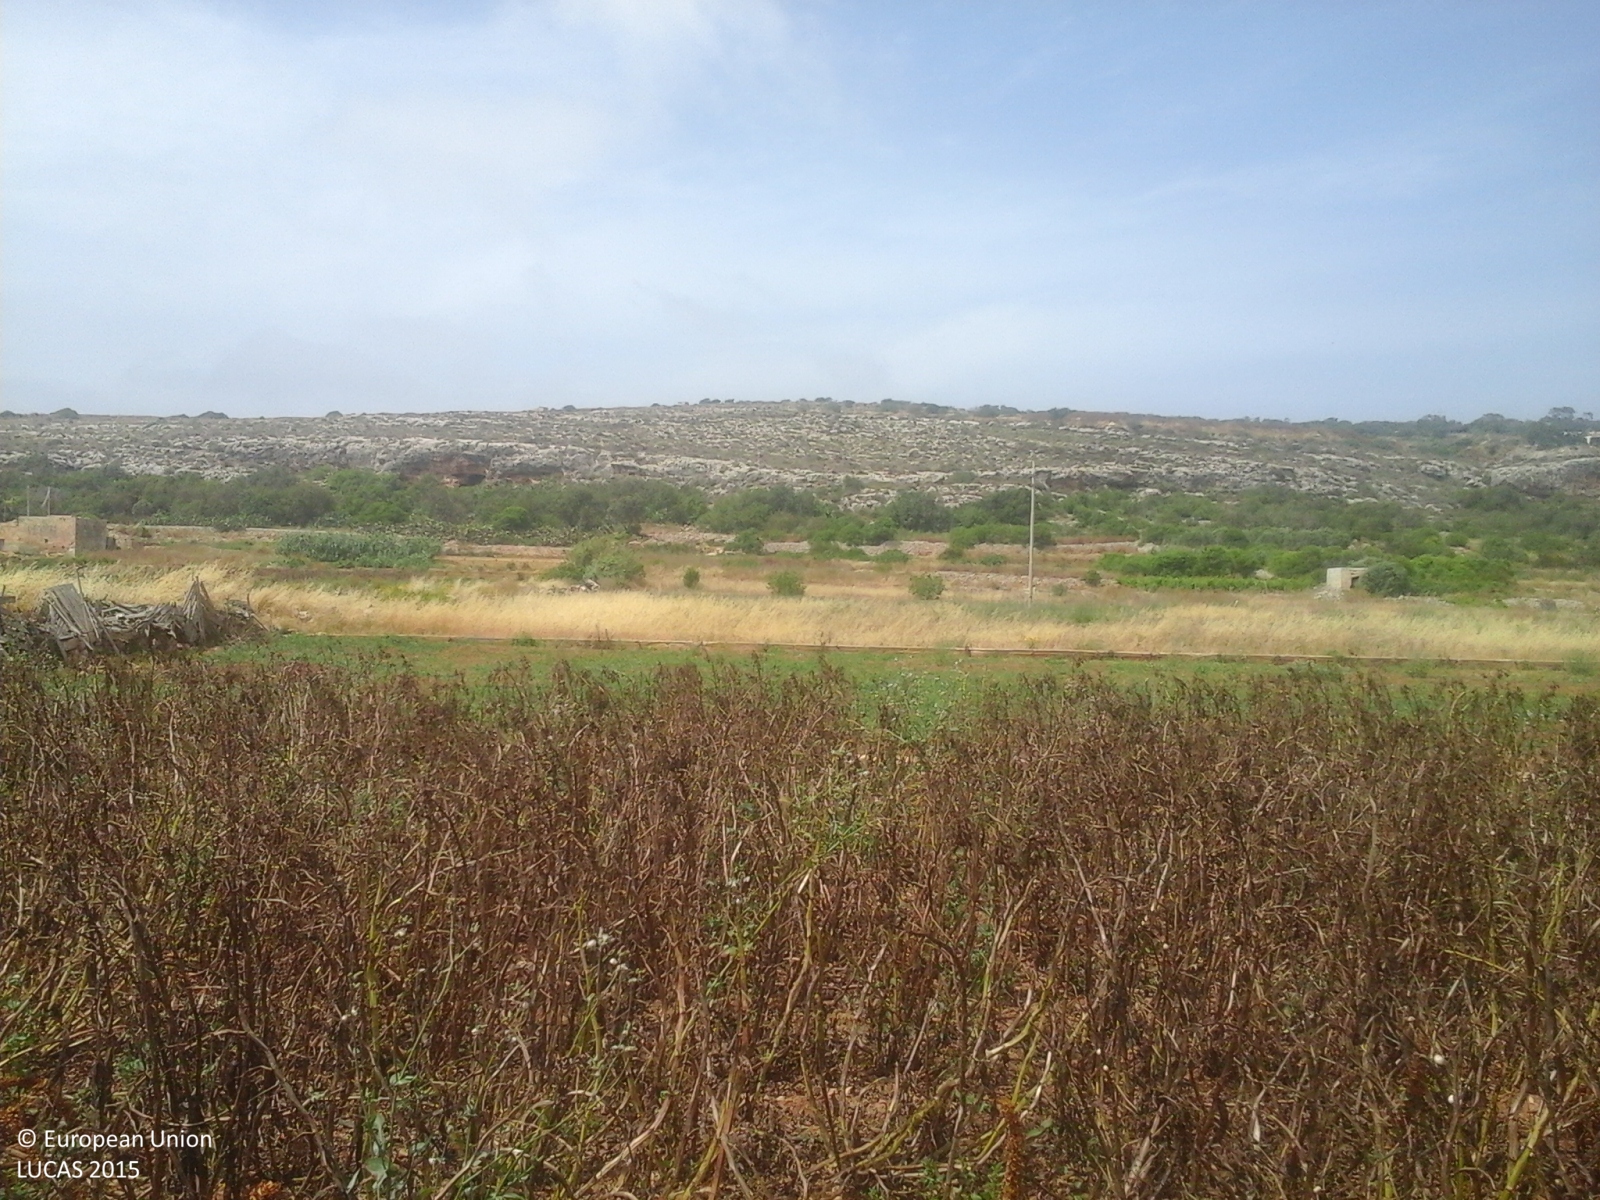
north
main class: Cropland
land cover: Dry pulses
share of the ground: > 75 %
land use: Agriculture (excluding fallow land and kitchen gardens)
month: May
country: MT
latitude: 35.9371
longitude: 14.3604
